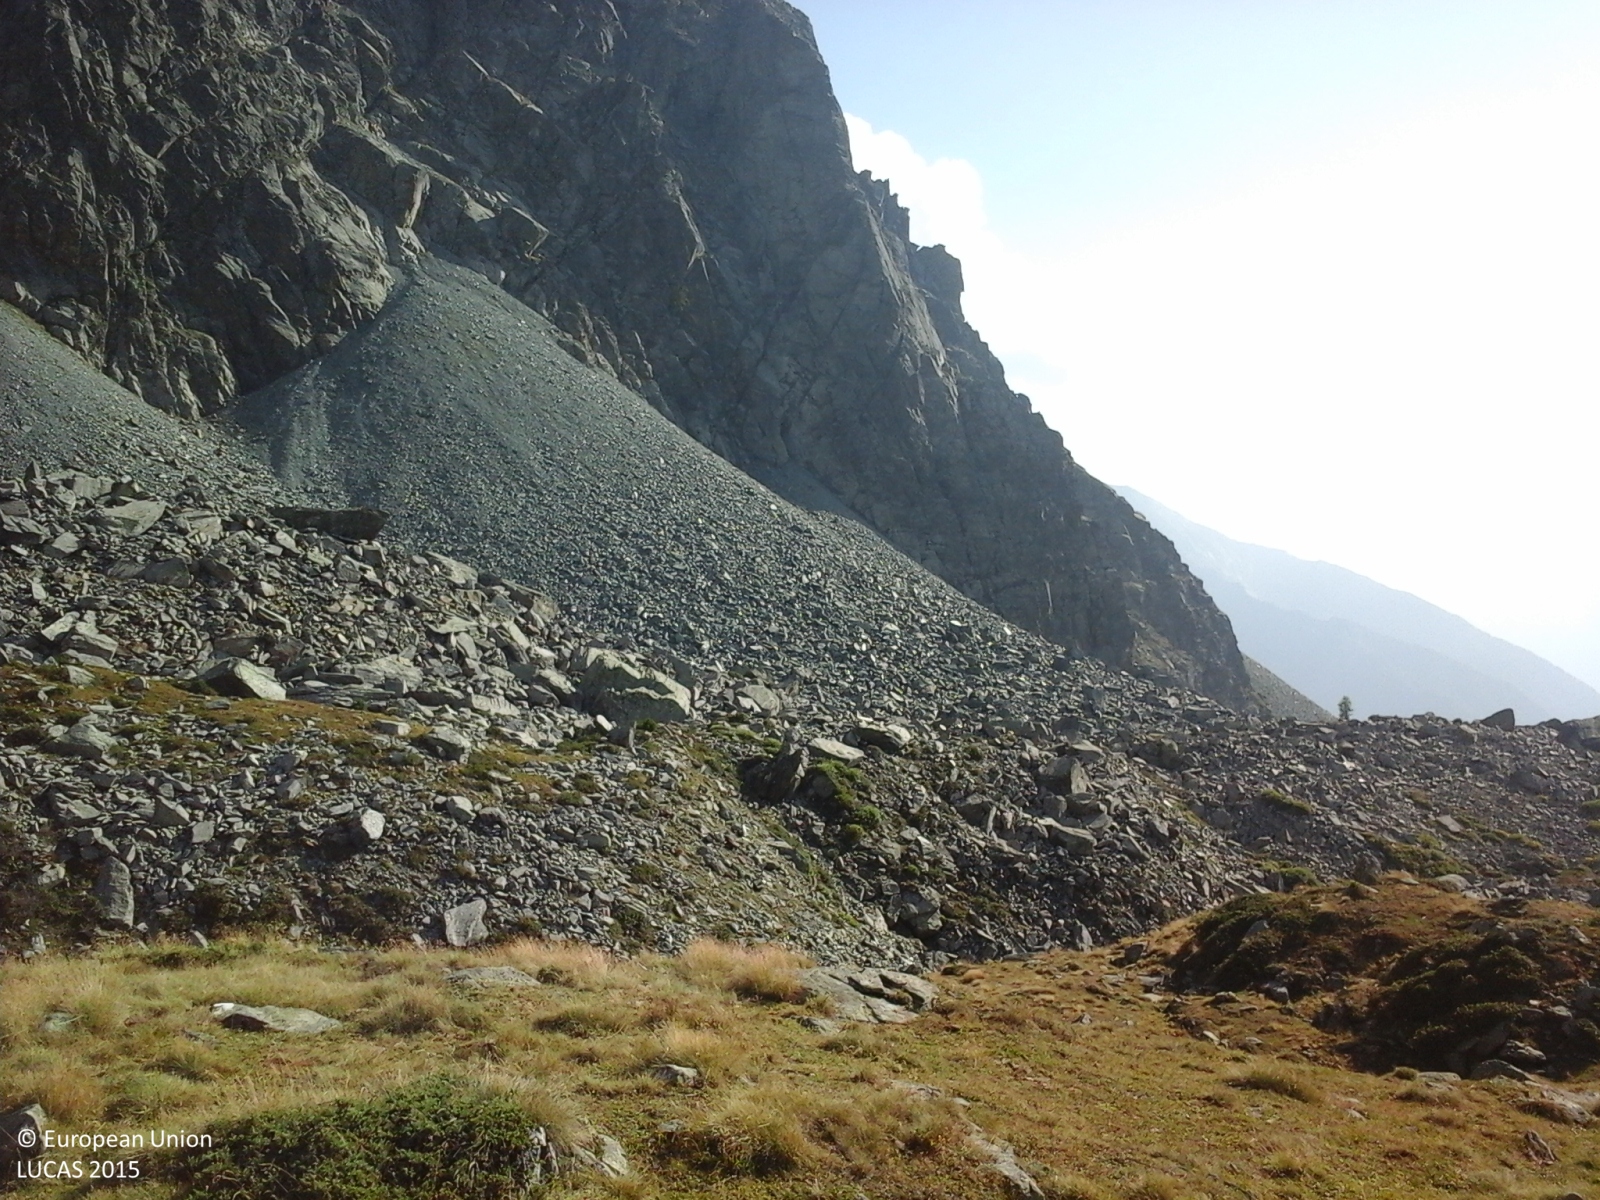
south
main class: Grassland
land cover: Grassland without tree/shrub cover
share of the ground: > 75 %
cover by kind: herbaceous plants 100 %
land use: Agriculture (excluding fallow land and kitchen gardens)
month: August
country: IT
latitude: 45.8410
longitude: 7.7499
